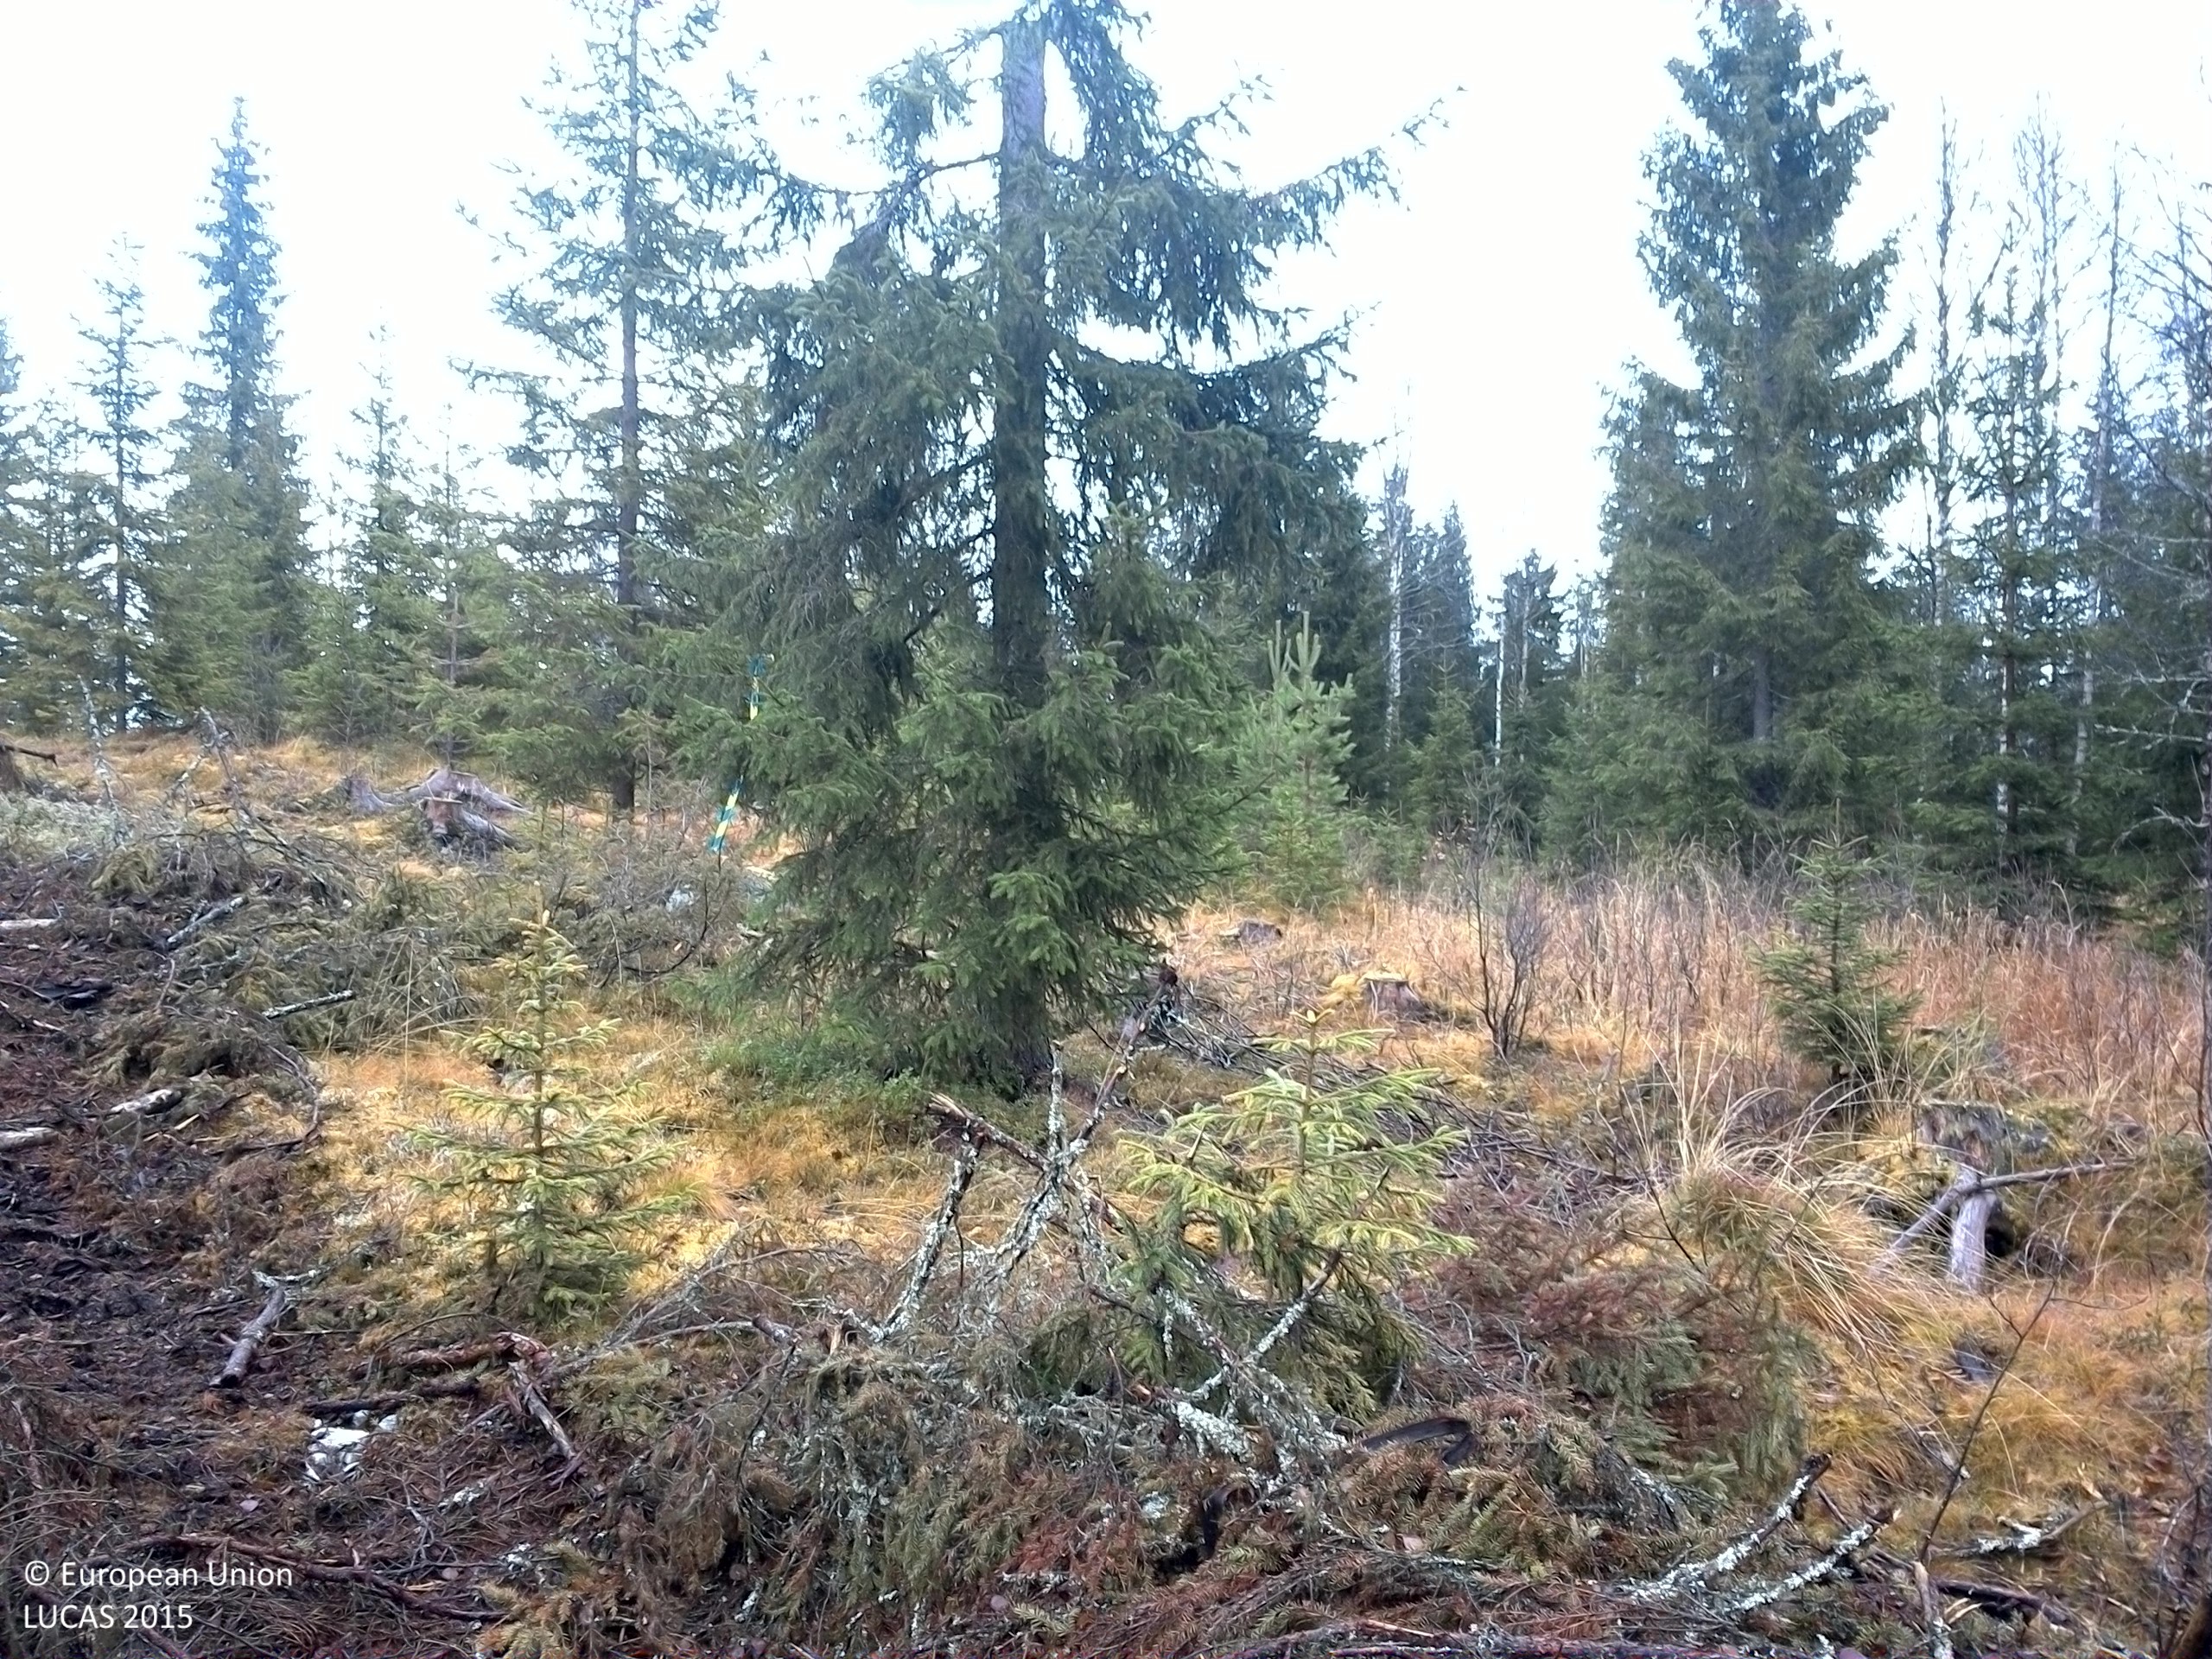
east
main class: Woodland
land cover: Spruce dominated mixed woodland
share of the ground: 10 - 25 %
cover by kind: lichens and mosses 30 %, shrubs 25 %, herbaceous plants 15 %, unconsolidated bare surface 15 %, coniferous forest trees 10 %, broadleaved forest trees 5 %
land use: Forestry
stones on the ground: 25 - 50 %
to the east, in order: Spruce dominated mixed woodland; Rivers and streams; Spruce dominated coniferous woodland
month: October
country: SE
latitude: 63.7885
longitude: 15.1897
